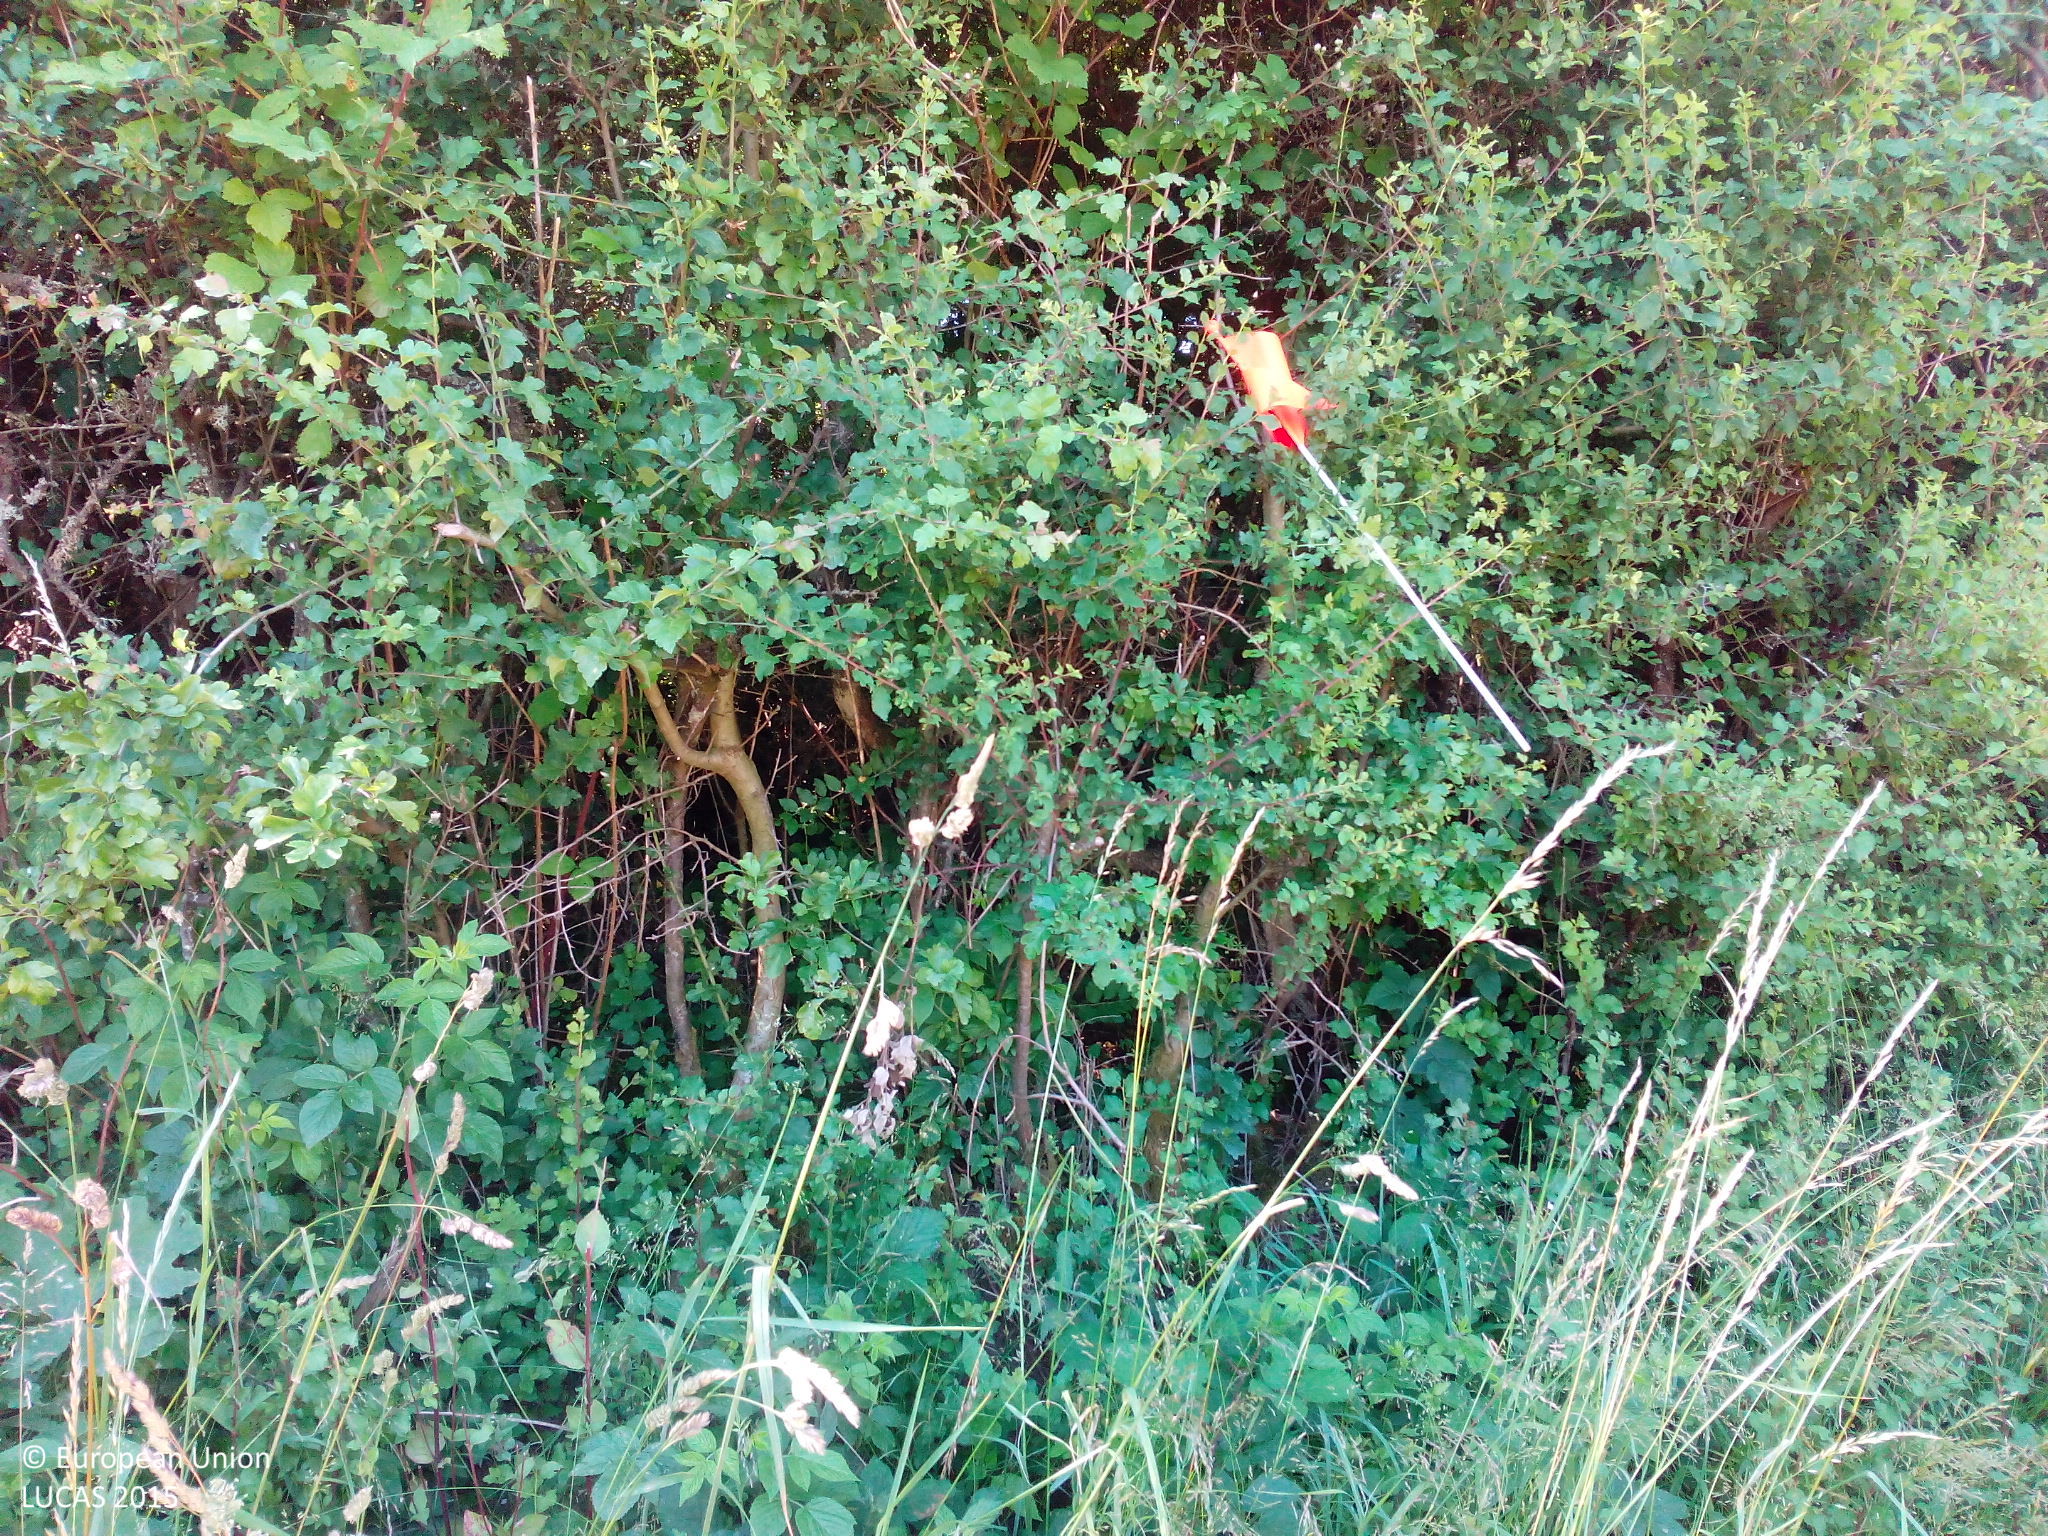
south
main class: Woodland
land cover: Broadleaved woodland
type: acidophilous oak and oak-birch forest
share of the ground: 50 - 75 %
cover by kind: broadleaved forest trees 60 %, shrubs 40 %
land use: Abandoned areas
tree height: < 5 m
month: July
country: DE
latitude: 49.5283
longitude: 7.5550
